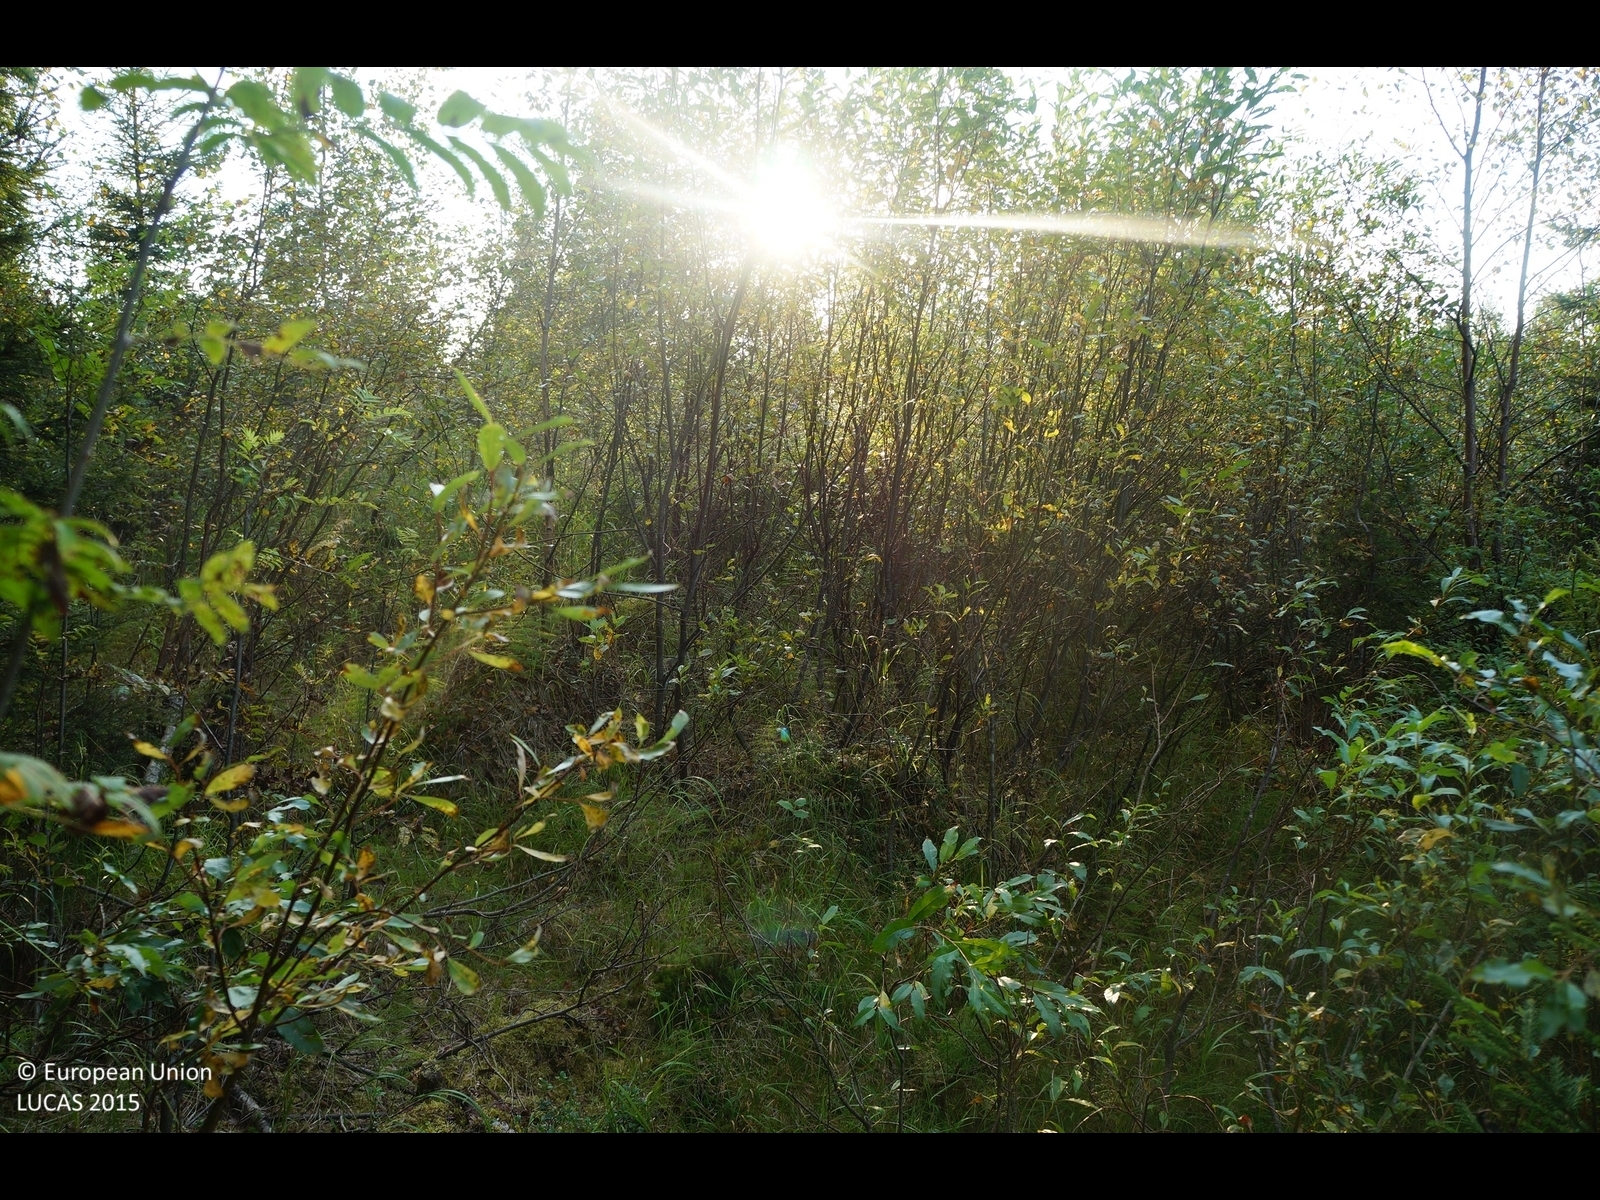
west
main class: Woodland
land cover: Spruce dominated mixed woodland
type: boreal forest
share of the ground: 50 - 75 %
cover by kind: coniferous forest trees 45 %, shrubs 25 %, broadleaved forest trees 20 %, herbaceous plants 5 %, lichens and mosses 5 %
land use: Forestry
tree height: > 5 m
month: August
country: FI
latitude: 64.1563
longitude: 25.0313
